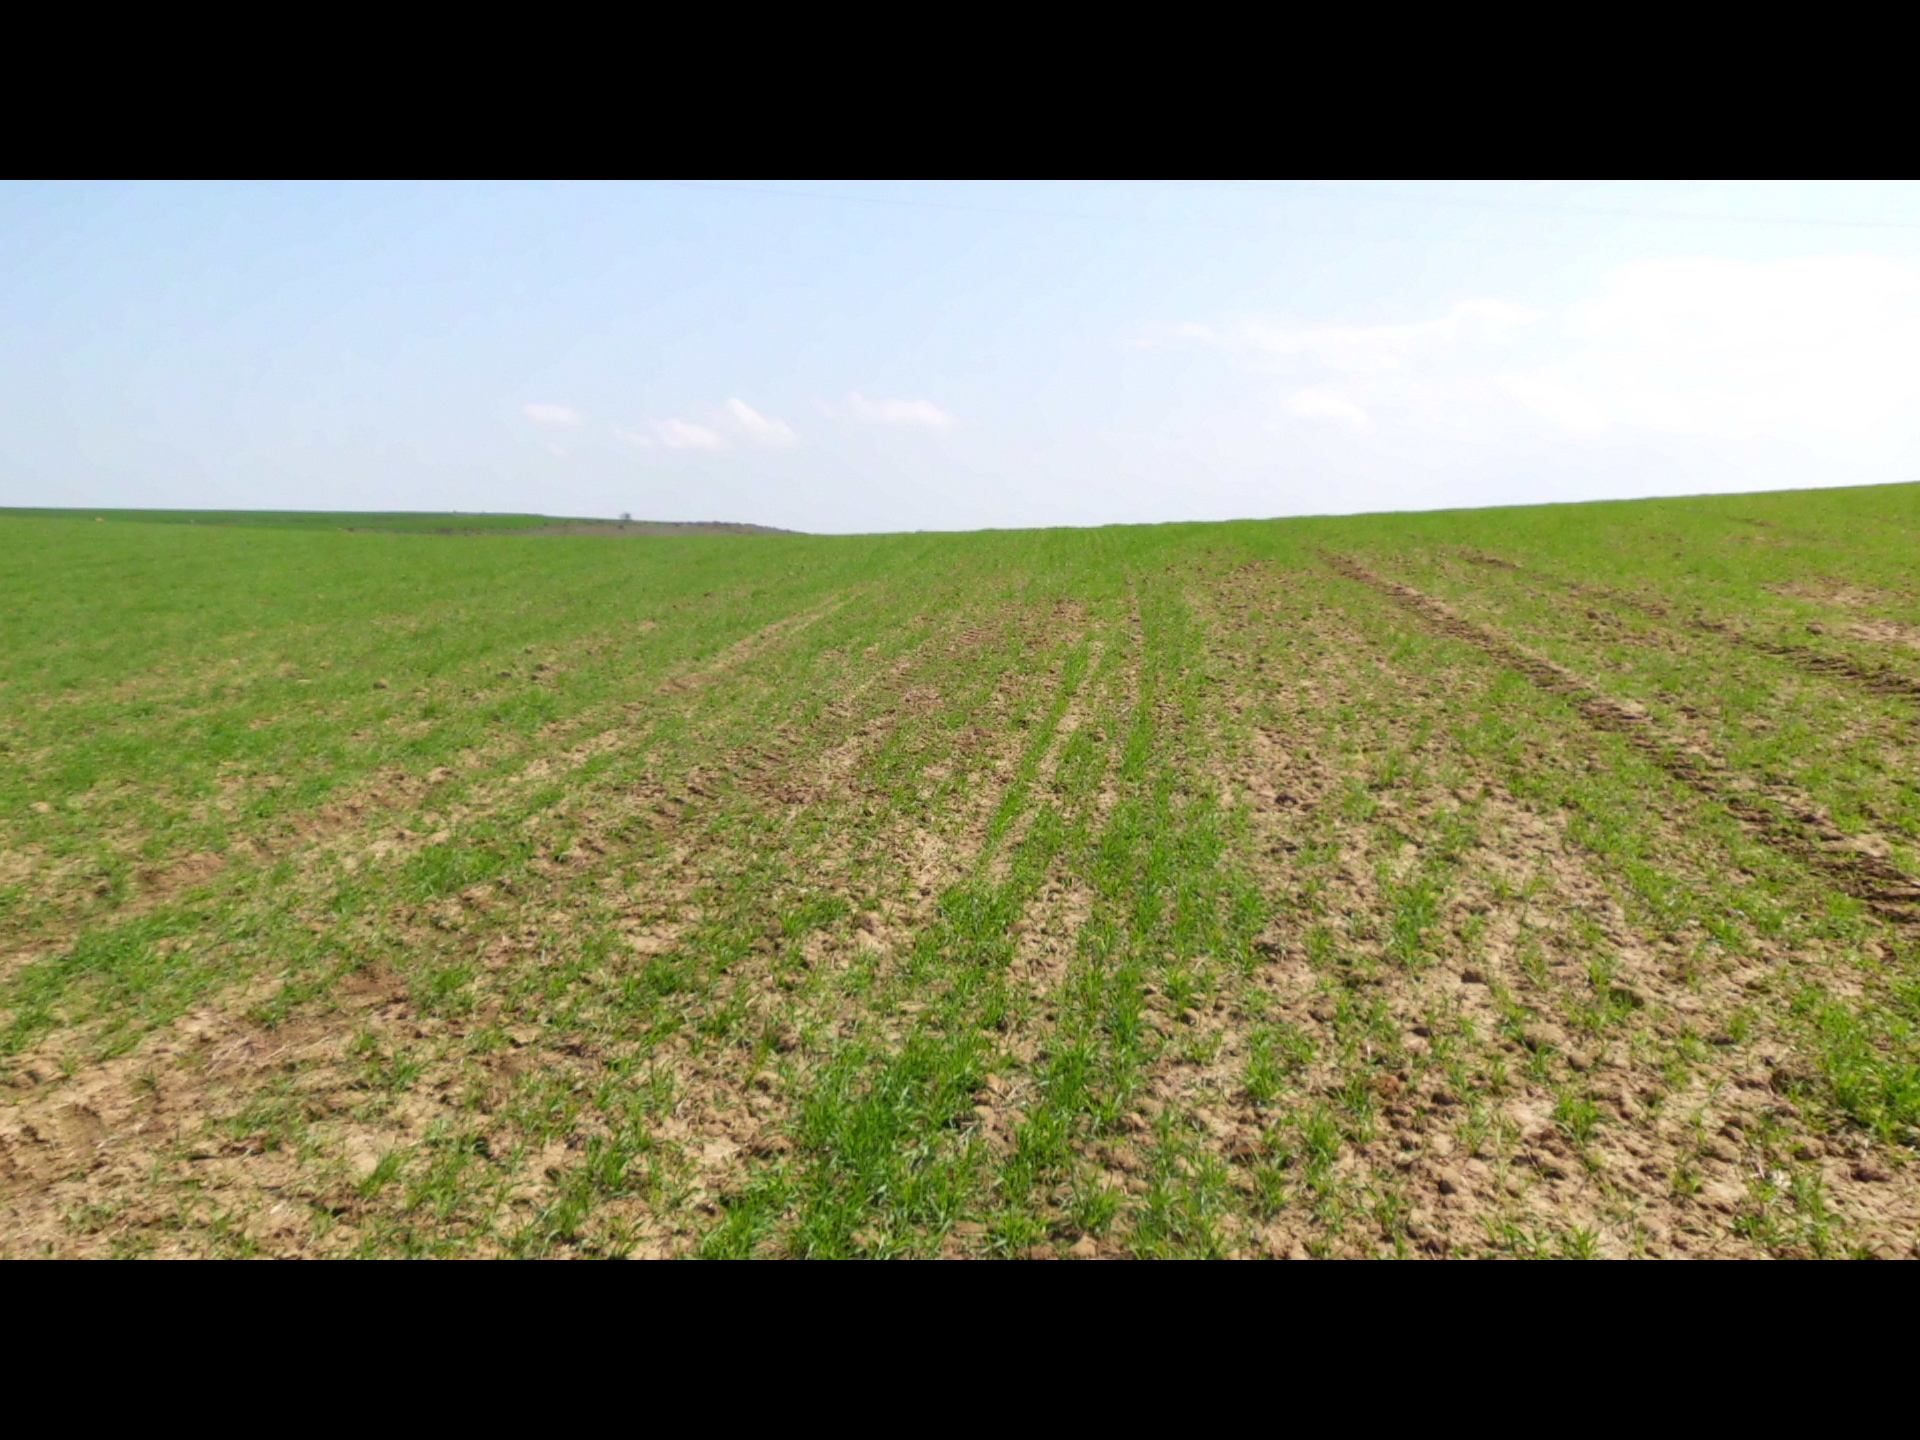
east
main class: Cropland
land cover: Barley
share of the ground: > 75 %
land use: Agriculture (excluding fallow land and kitchen gardens)
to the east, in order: Barley; Grass margins; Common wheat; Grassland without tree/shrub cover
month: April
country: ES
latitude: 42.5218
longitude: -3.7083
